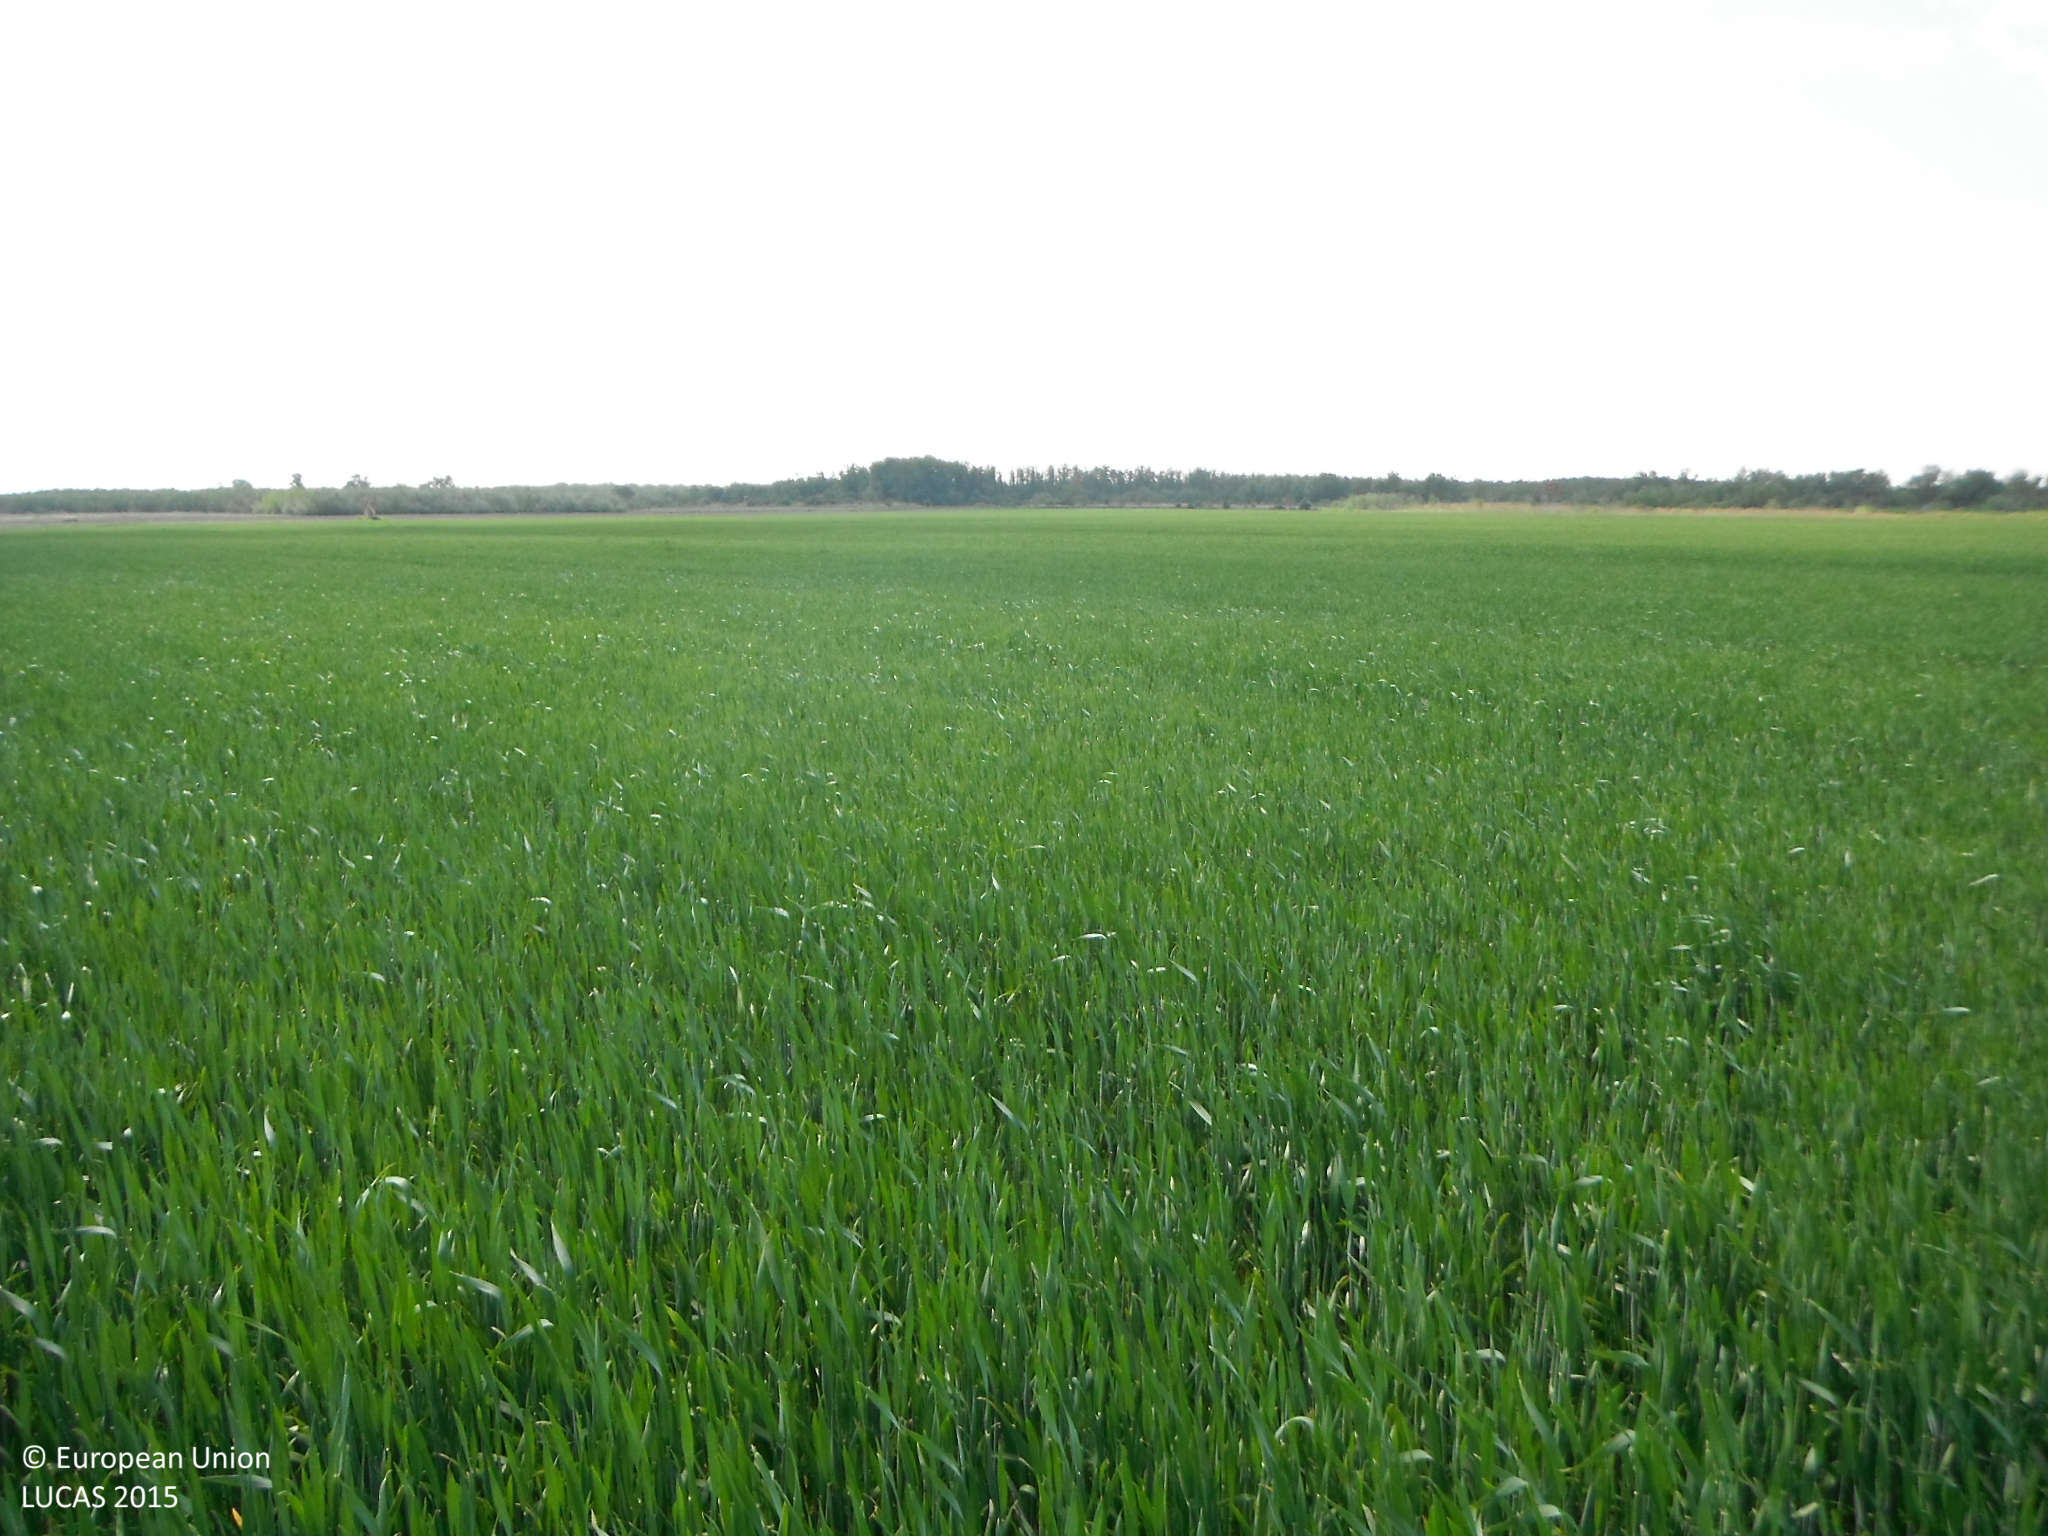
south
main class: Cropland
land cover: Common wheat
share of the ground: > 75 %
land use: Agriculture (excluding fallow land and kitchen gardens)
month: May
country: SK
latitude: 48.2562
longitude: 17.2418
